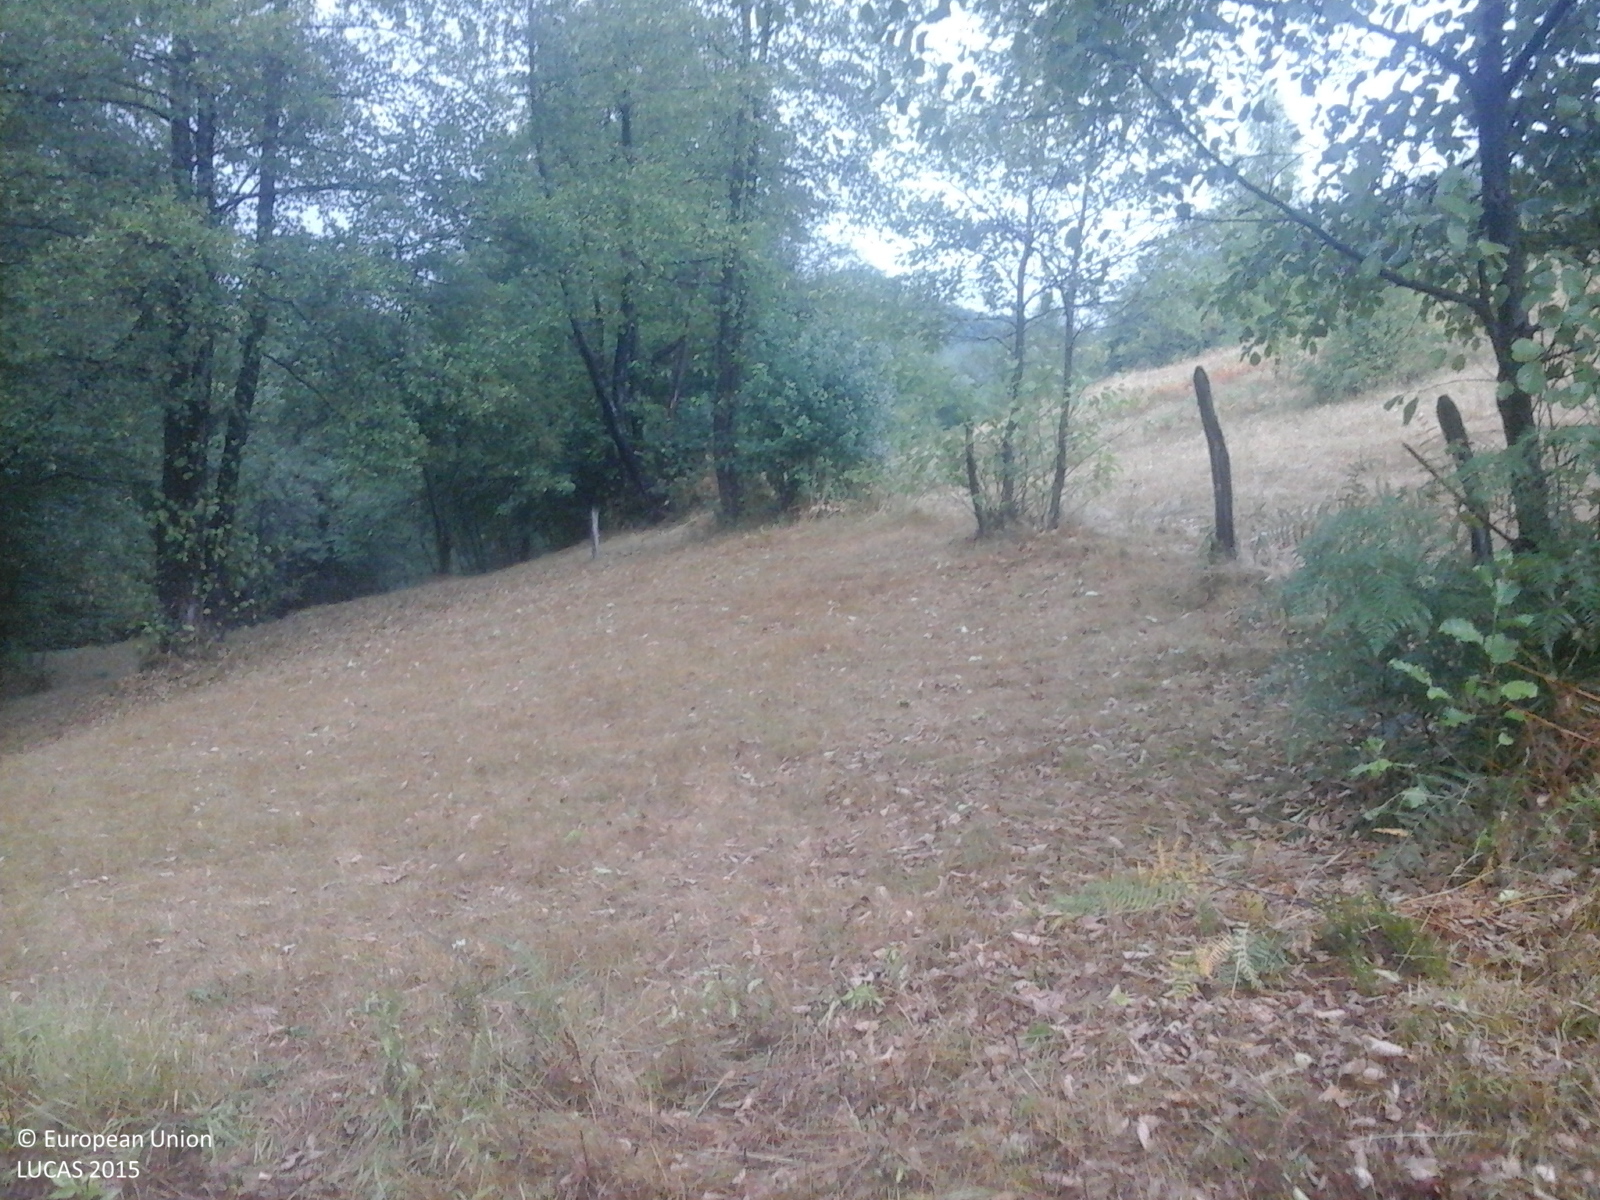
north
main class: Grassland
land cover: Grassland without tree/shrub cover
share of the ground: > 75 %
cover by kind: herbaceous plants 100 %
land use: Agriculture (excluding fallow land and kitchen gardens)
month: August
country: RO
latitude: 44.9756
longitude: 22.6612
